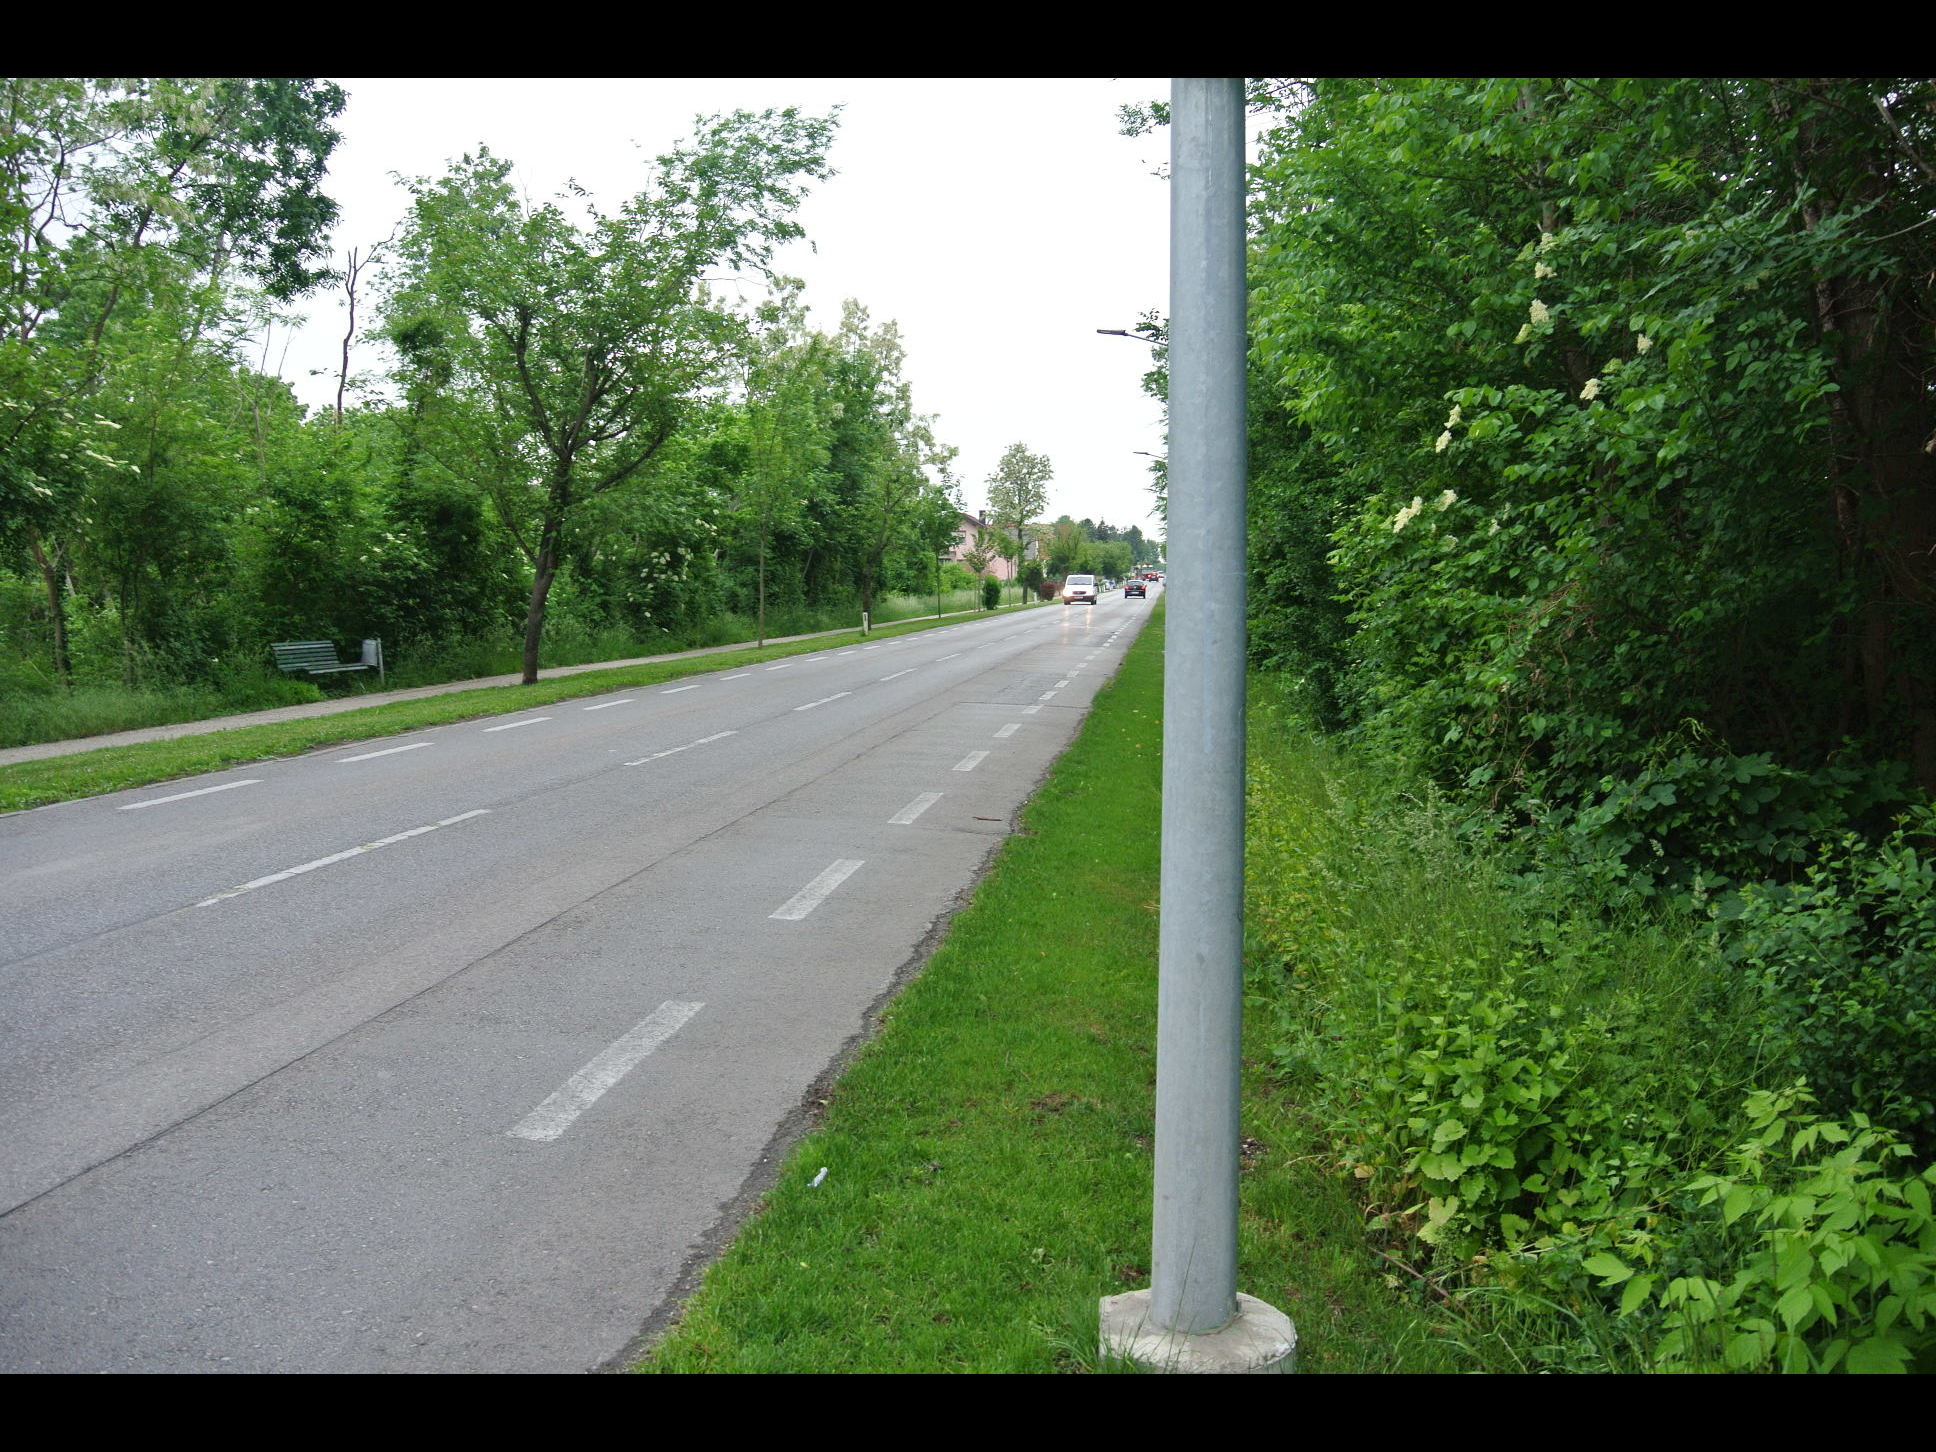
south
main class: Woodland
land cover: Broadleaved woodland
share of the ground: > 75 %
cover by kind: broadleaved forest trees 85 %, shrubs 15 %
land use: Semi-natural and natural areas not in use
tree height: > 5 m
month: May
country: AT
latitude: 48.0164
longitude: 16.4536
